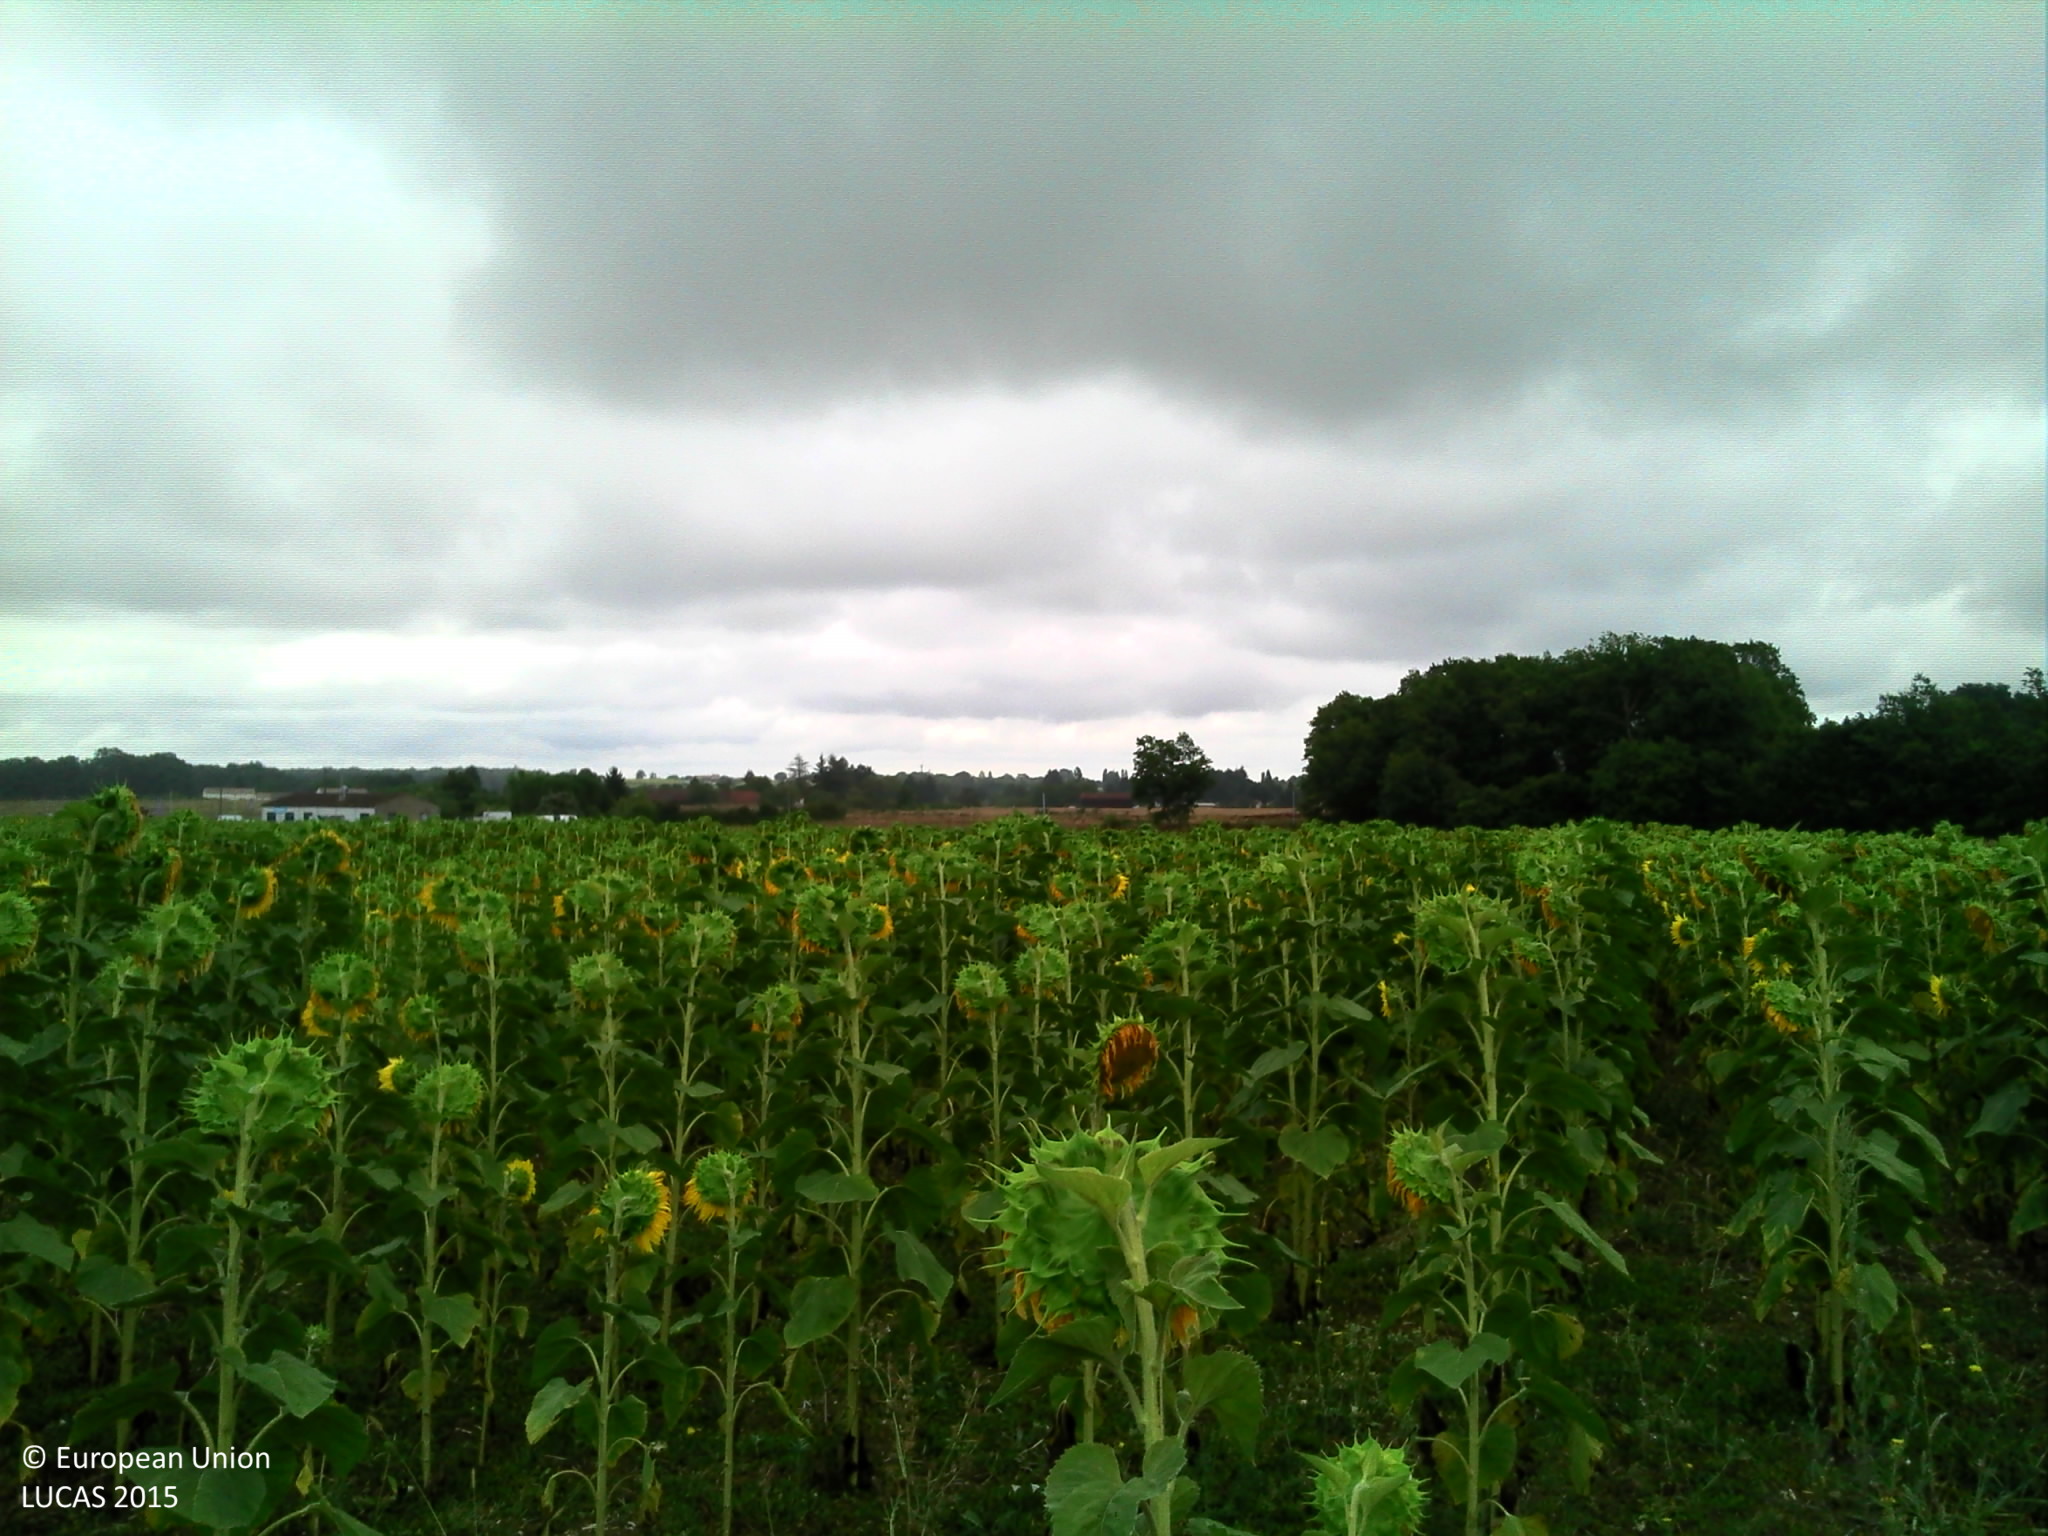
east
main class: Cropland
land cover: Sunflower
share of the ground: 50 - 75 %
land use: Agriculture (excluding fallow land and kitchen gardens)
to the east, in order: Sunflower; Abandoned hedges; Sunflower; Grass margins; Paved roads, cycling and walking lanes; Grass margins; Ditches and canals; Common wheat
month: August
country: FR
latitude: 44.6911
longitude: 0.8706
